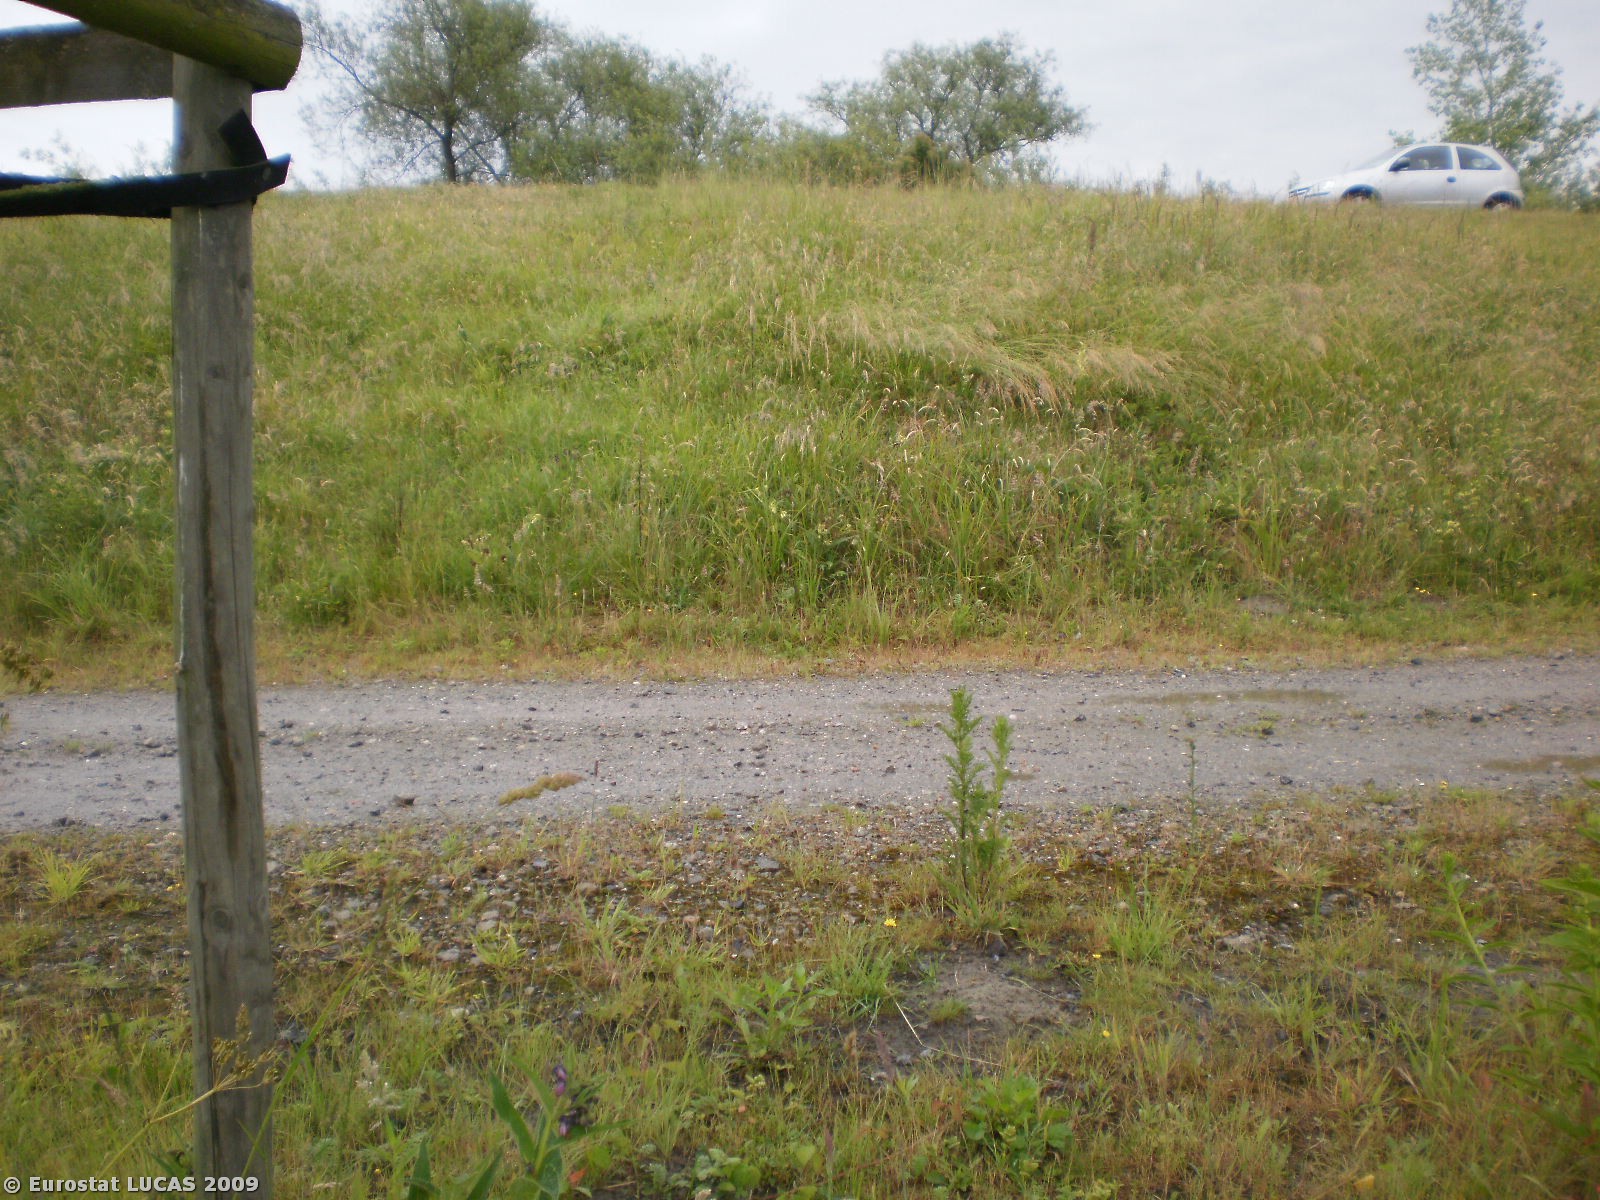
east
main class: Grassland
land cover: Grassland with sparse tree/shrub cover
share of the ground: > 75 %
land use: Nature reserves
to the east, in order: Grassland with sparse tree/shrub cover; Lines of trees; Grass margins; Paved roads, cycling and walking lanes; Grassland without tree/shrub cover; Paved roads, cycling and walking lanes; Shruby margins; Shrubland with sparse tree cover; Broadleaved woodland; Bare land; Inland running water
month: June
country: BE
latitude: 51.0814
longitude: 4.1849
